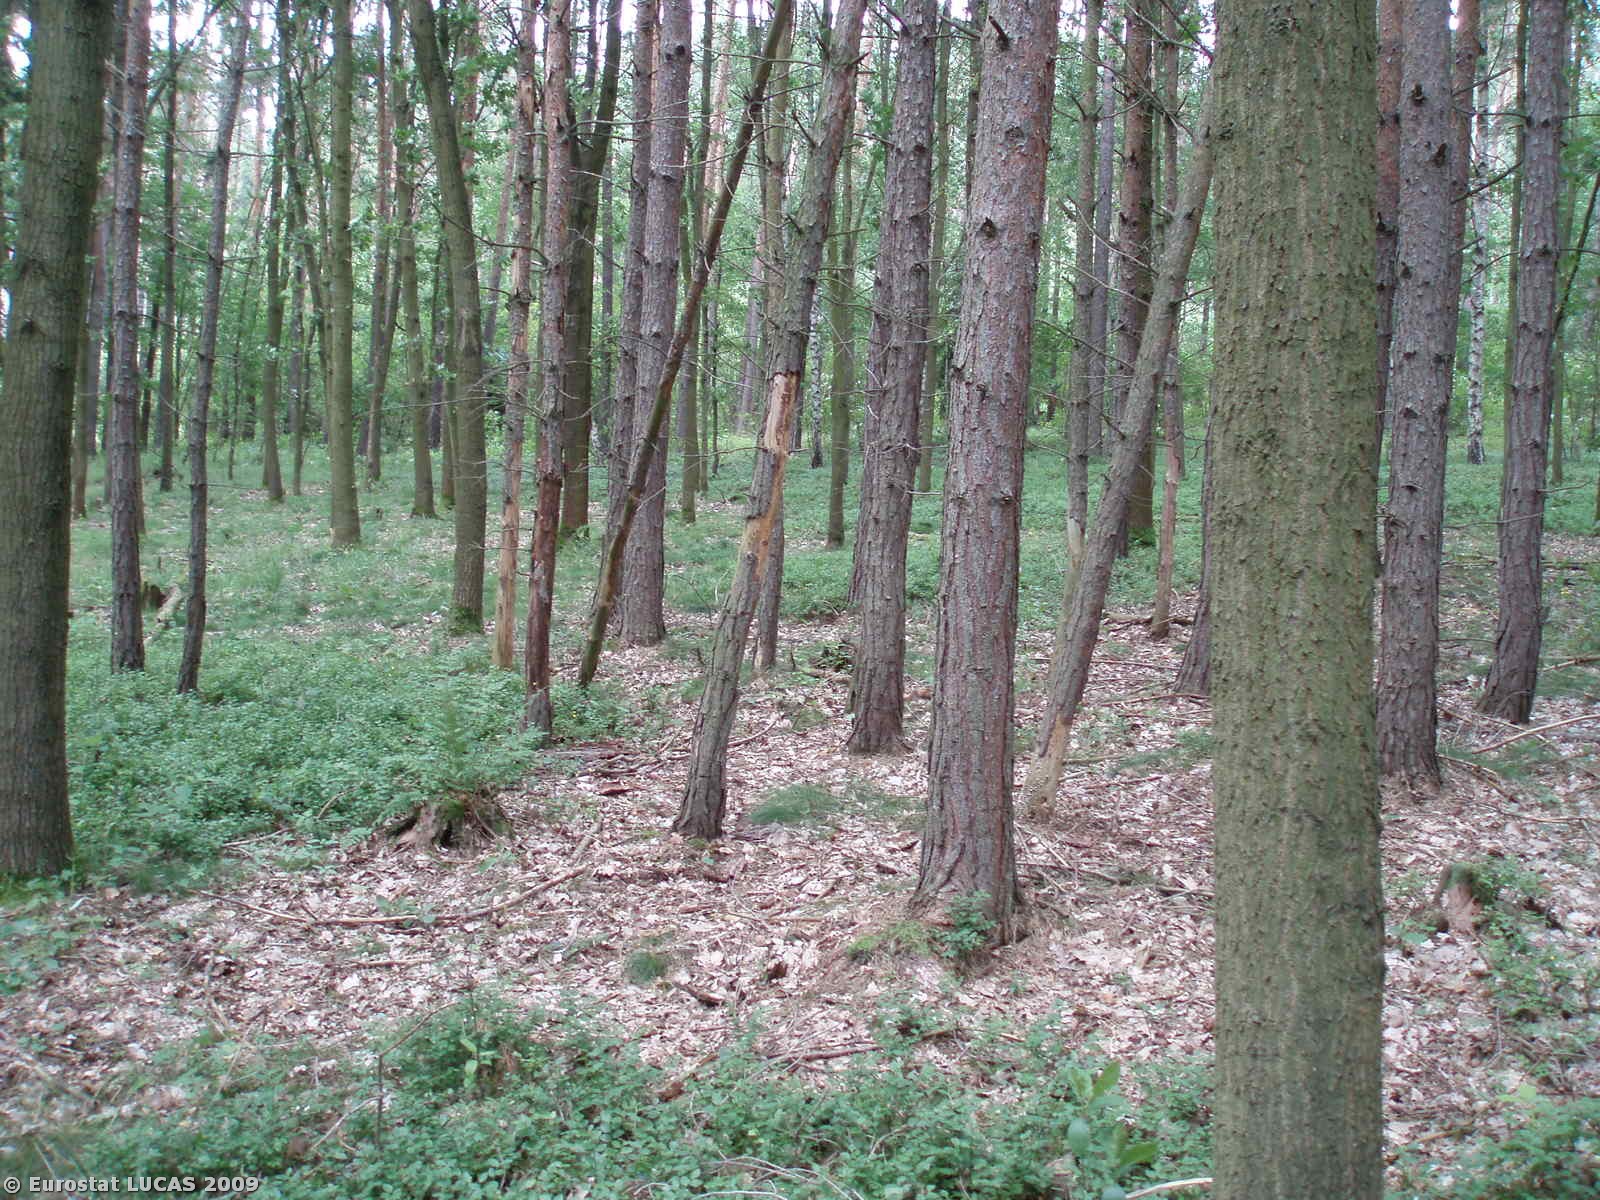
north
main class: Woodland
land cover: Mixed woodland
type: hemiboreal forest and nemoral coniferous forest and mixed broadleaved-coniferous forest
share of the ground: > 75 %
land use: Forestry
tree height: > 5 m
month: July
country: CZ
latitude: 49.5718
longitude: 12.8898
